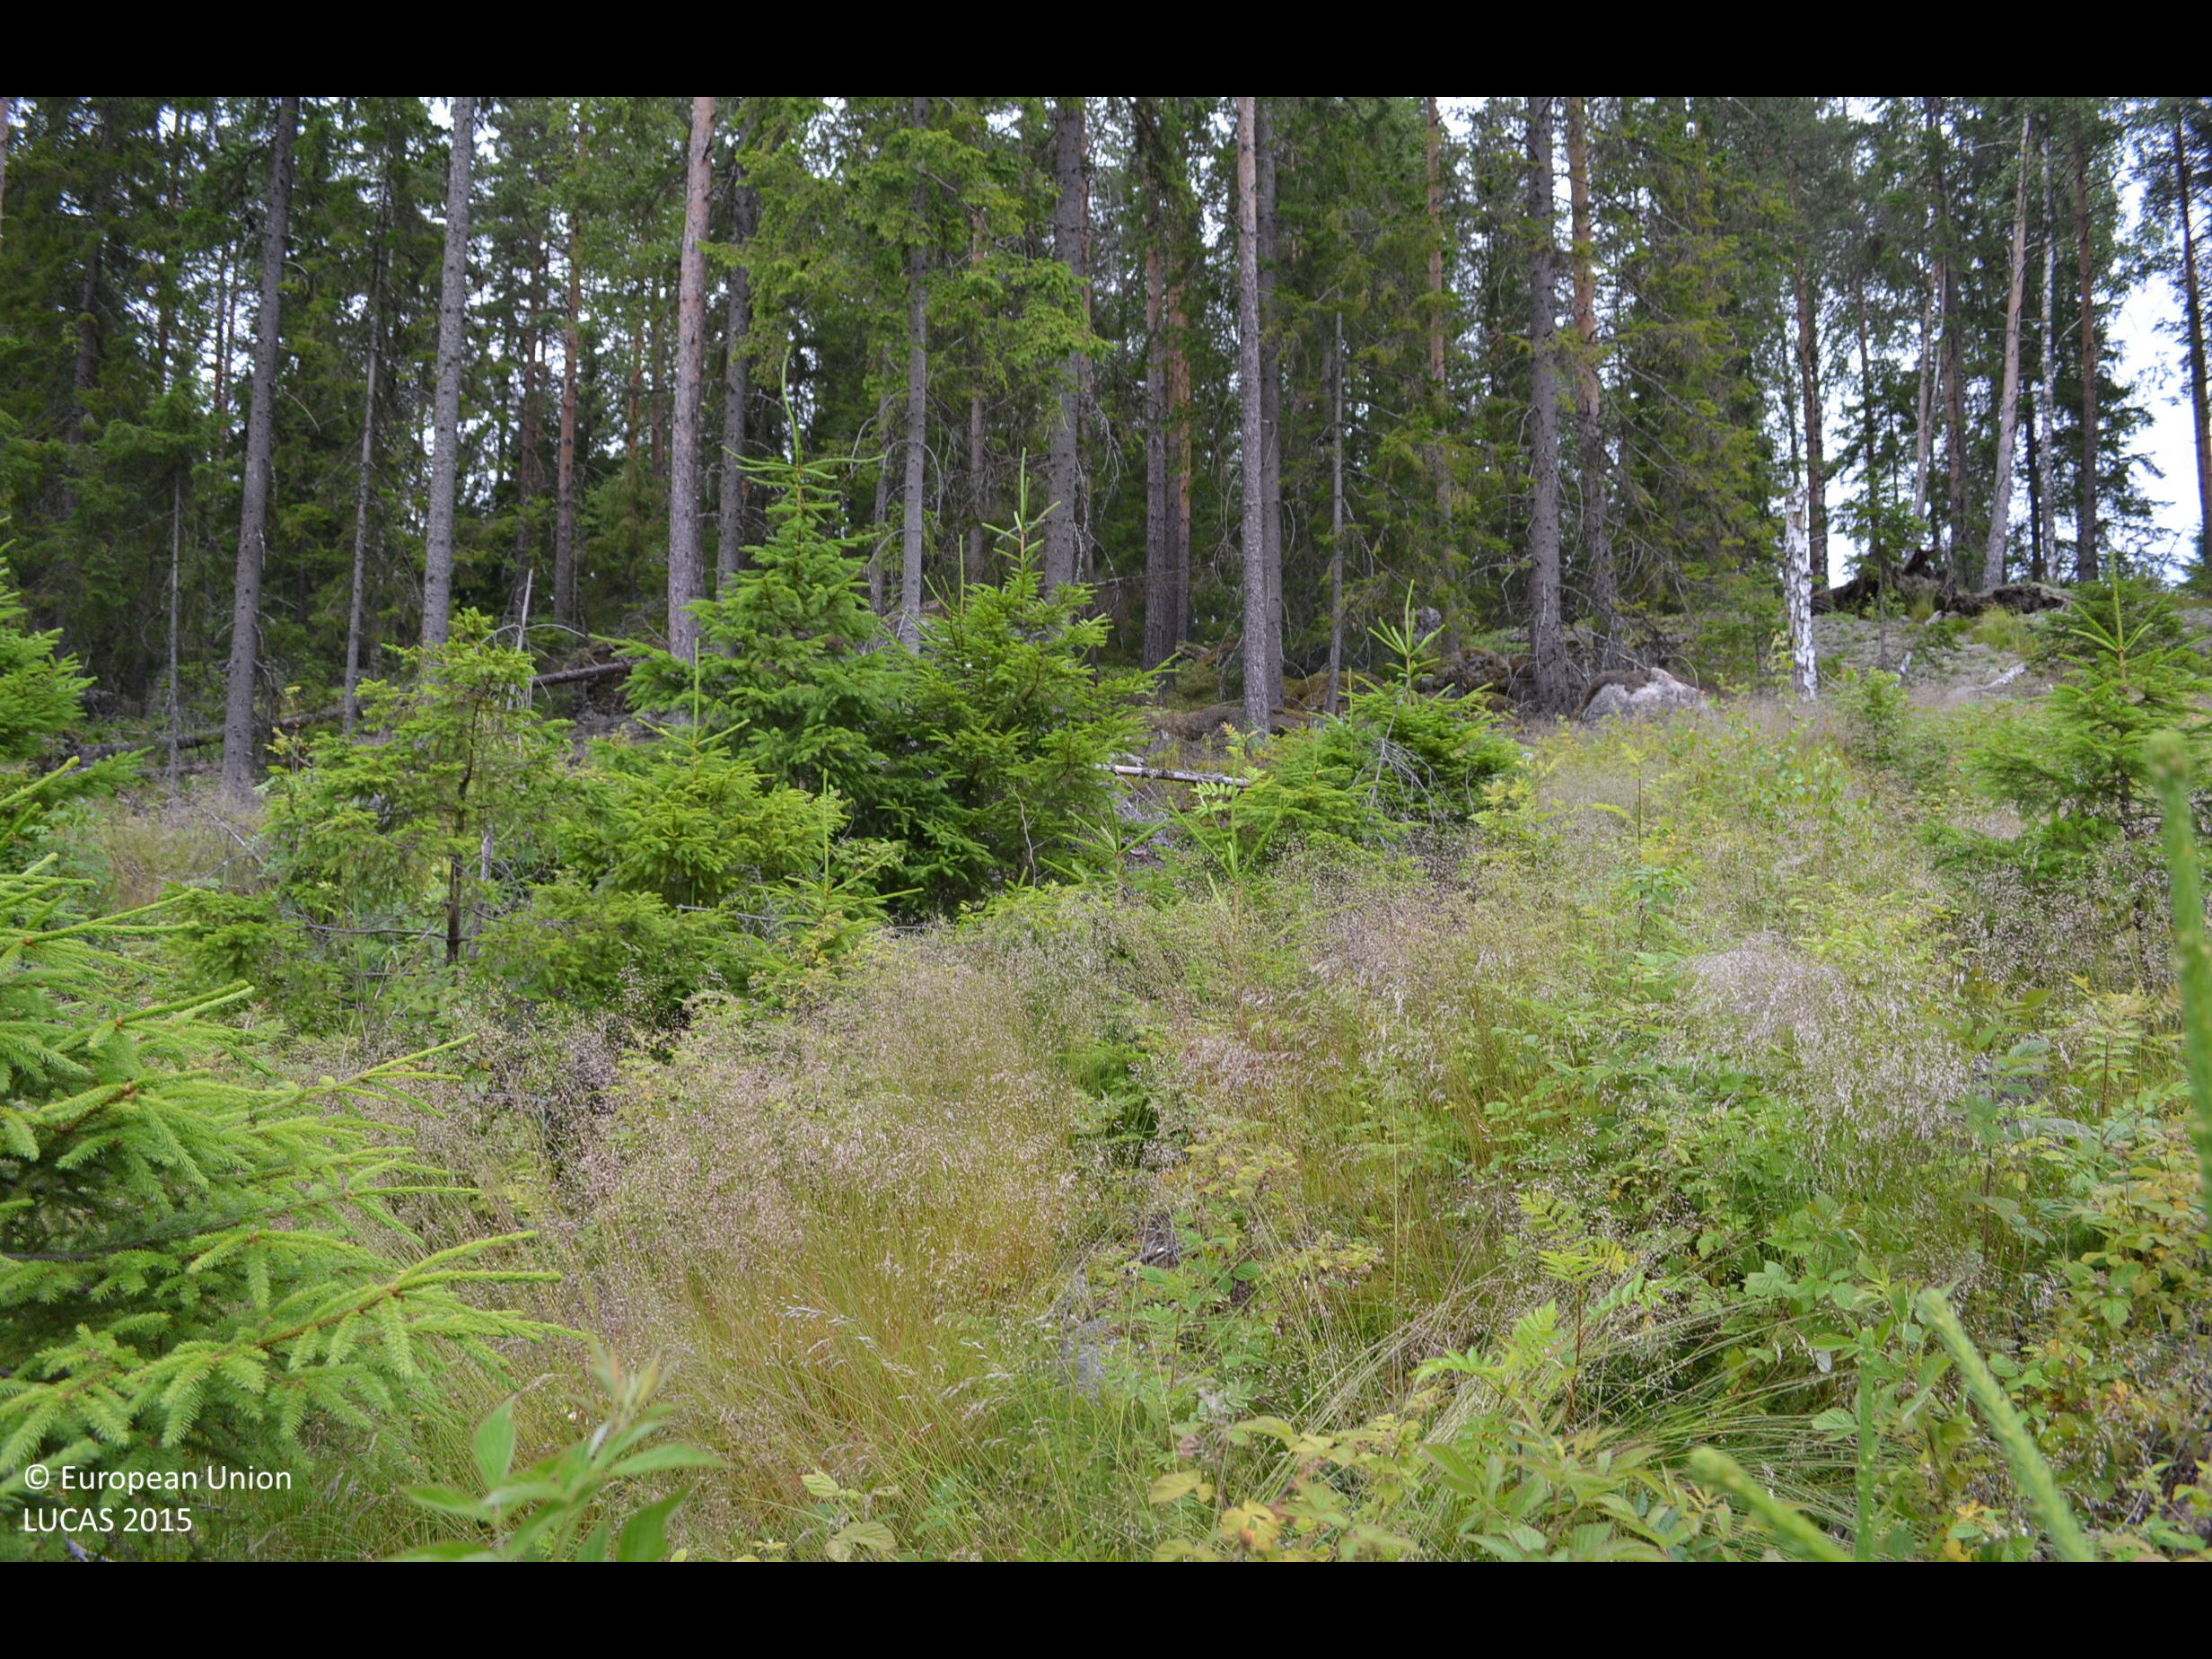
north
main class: Woodland
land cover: Spruce dominated mixed woodland
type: boreal forest
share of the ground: 25 - 50 %
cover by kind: herbaceous plants 60 %, broadleaved forest trees 20 %, coniferous forest trees 15 %, shrubs 5 %
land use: Forestry
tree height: < 5 m
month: July
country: FI
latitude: 61.6374
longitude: 23.2644
